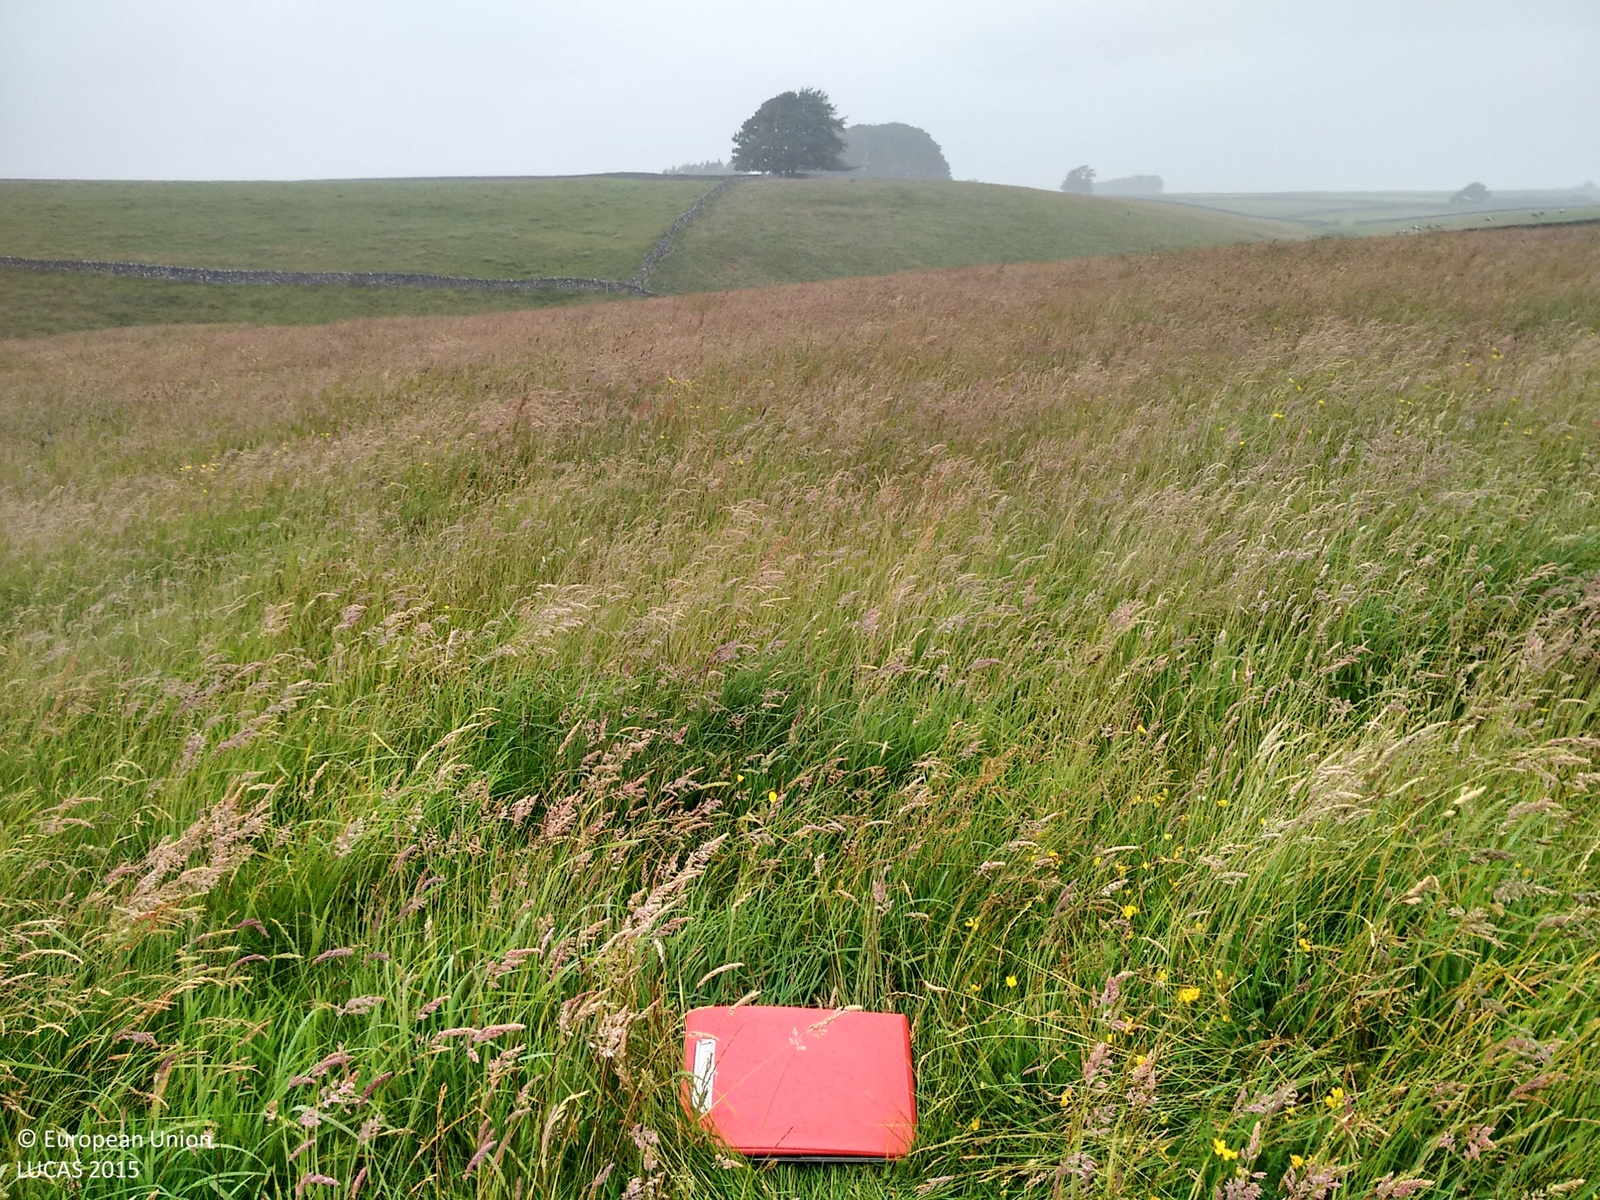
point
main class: Grassland
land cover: Grassland without tree/shrub cover
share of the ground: > 75 %
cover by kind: herbaceous plants 100 %
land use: Agriculture (excluding fallow land and kitchen gardens)
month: July
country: GB
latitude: 53.1917
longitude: -1.7432
